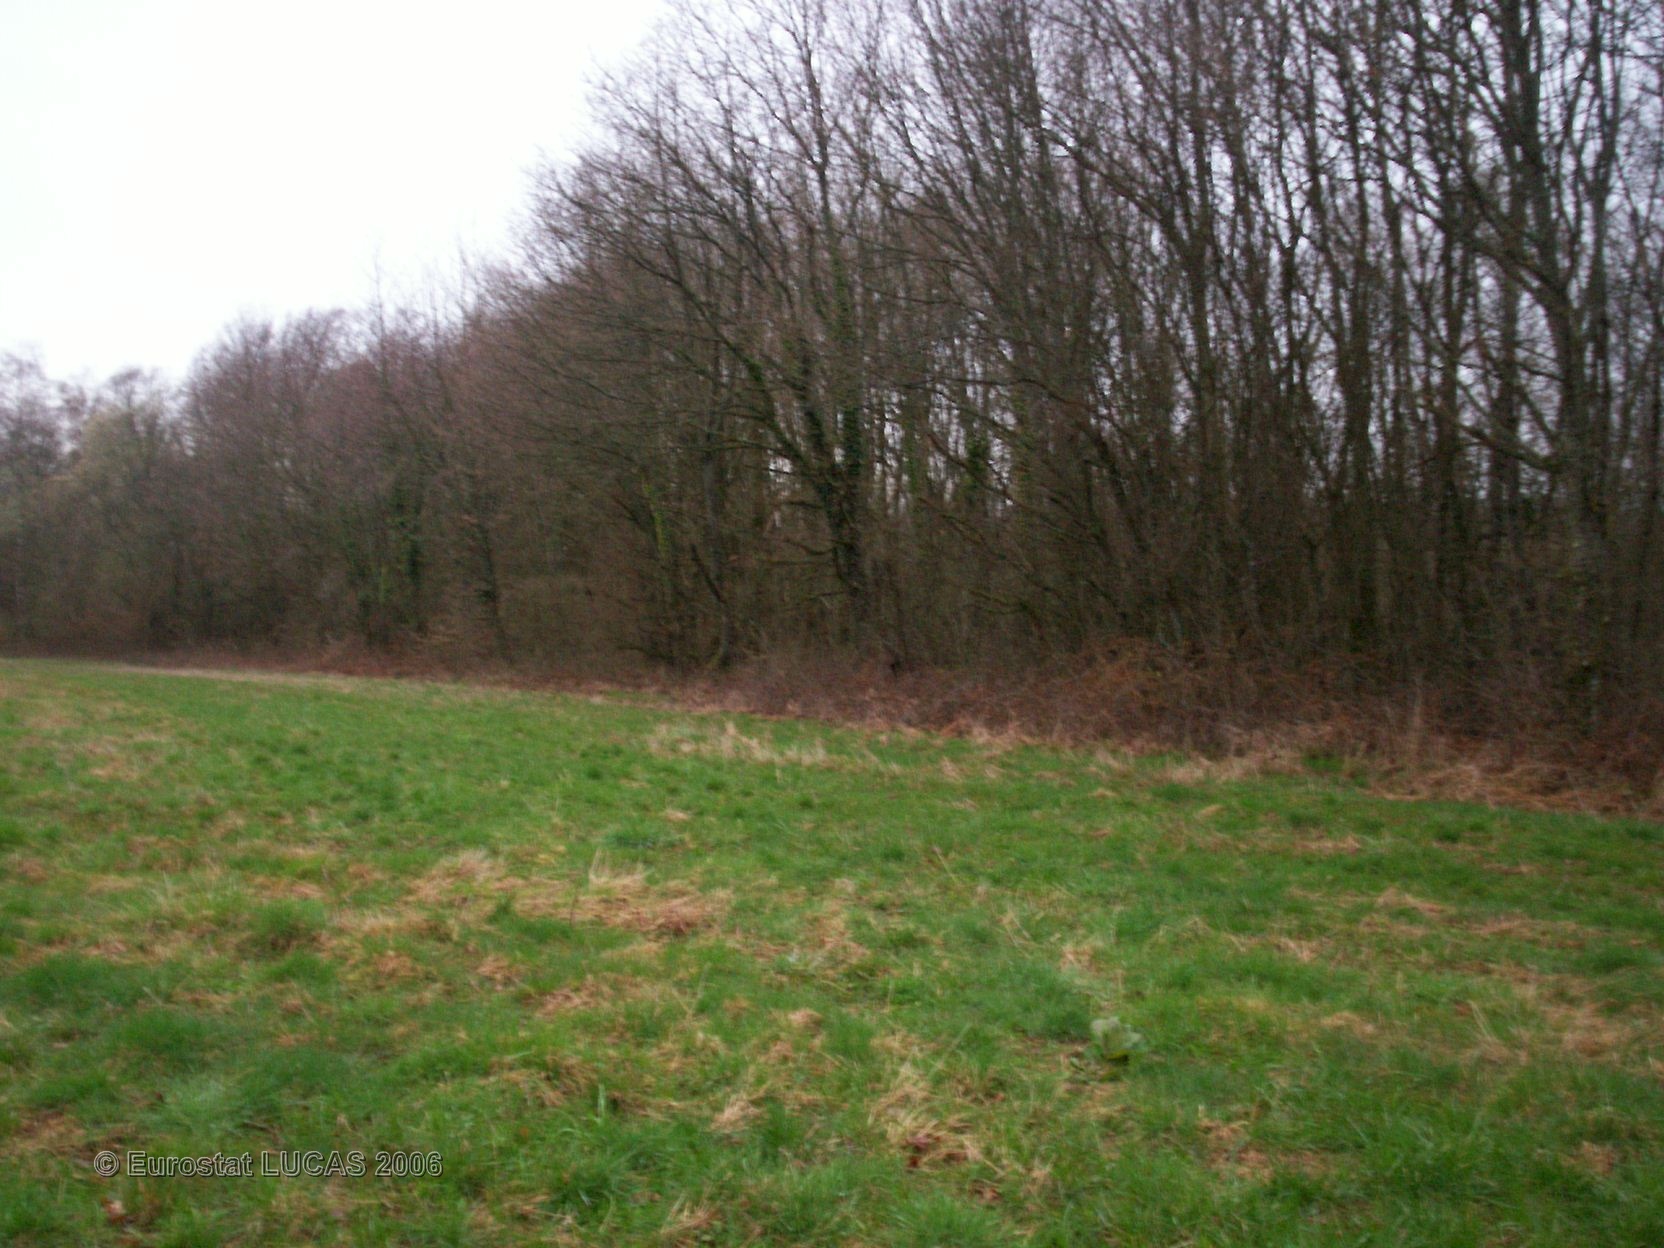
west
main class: Grassland
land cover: Grassland without tree/shrub cover
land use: Agriculture (excluding fallow land and kitchen gardens)
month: April
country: FR
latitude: 47.6122
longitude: 6.5825
